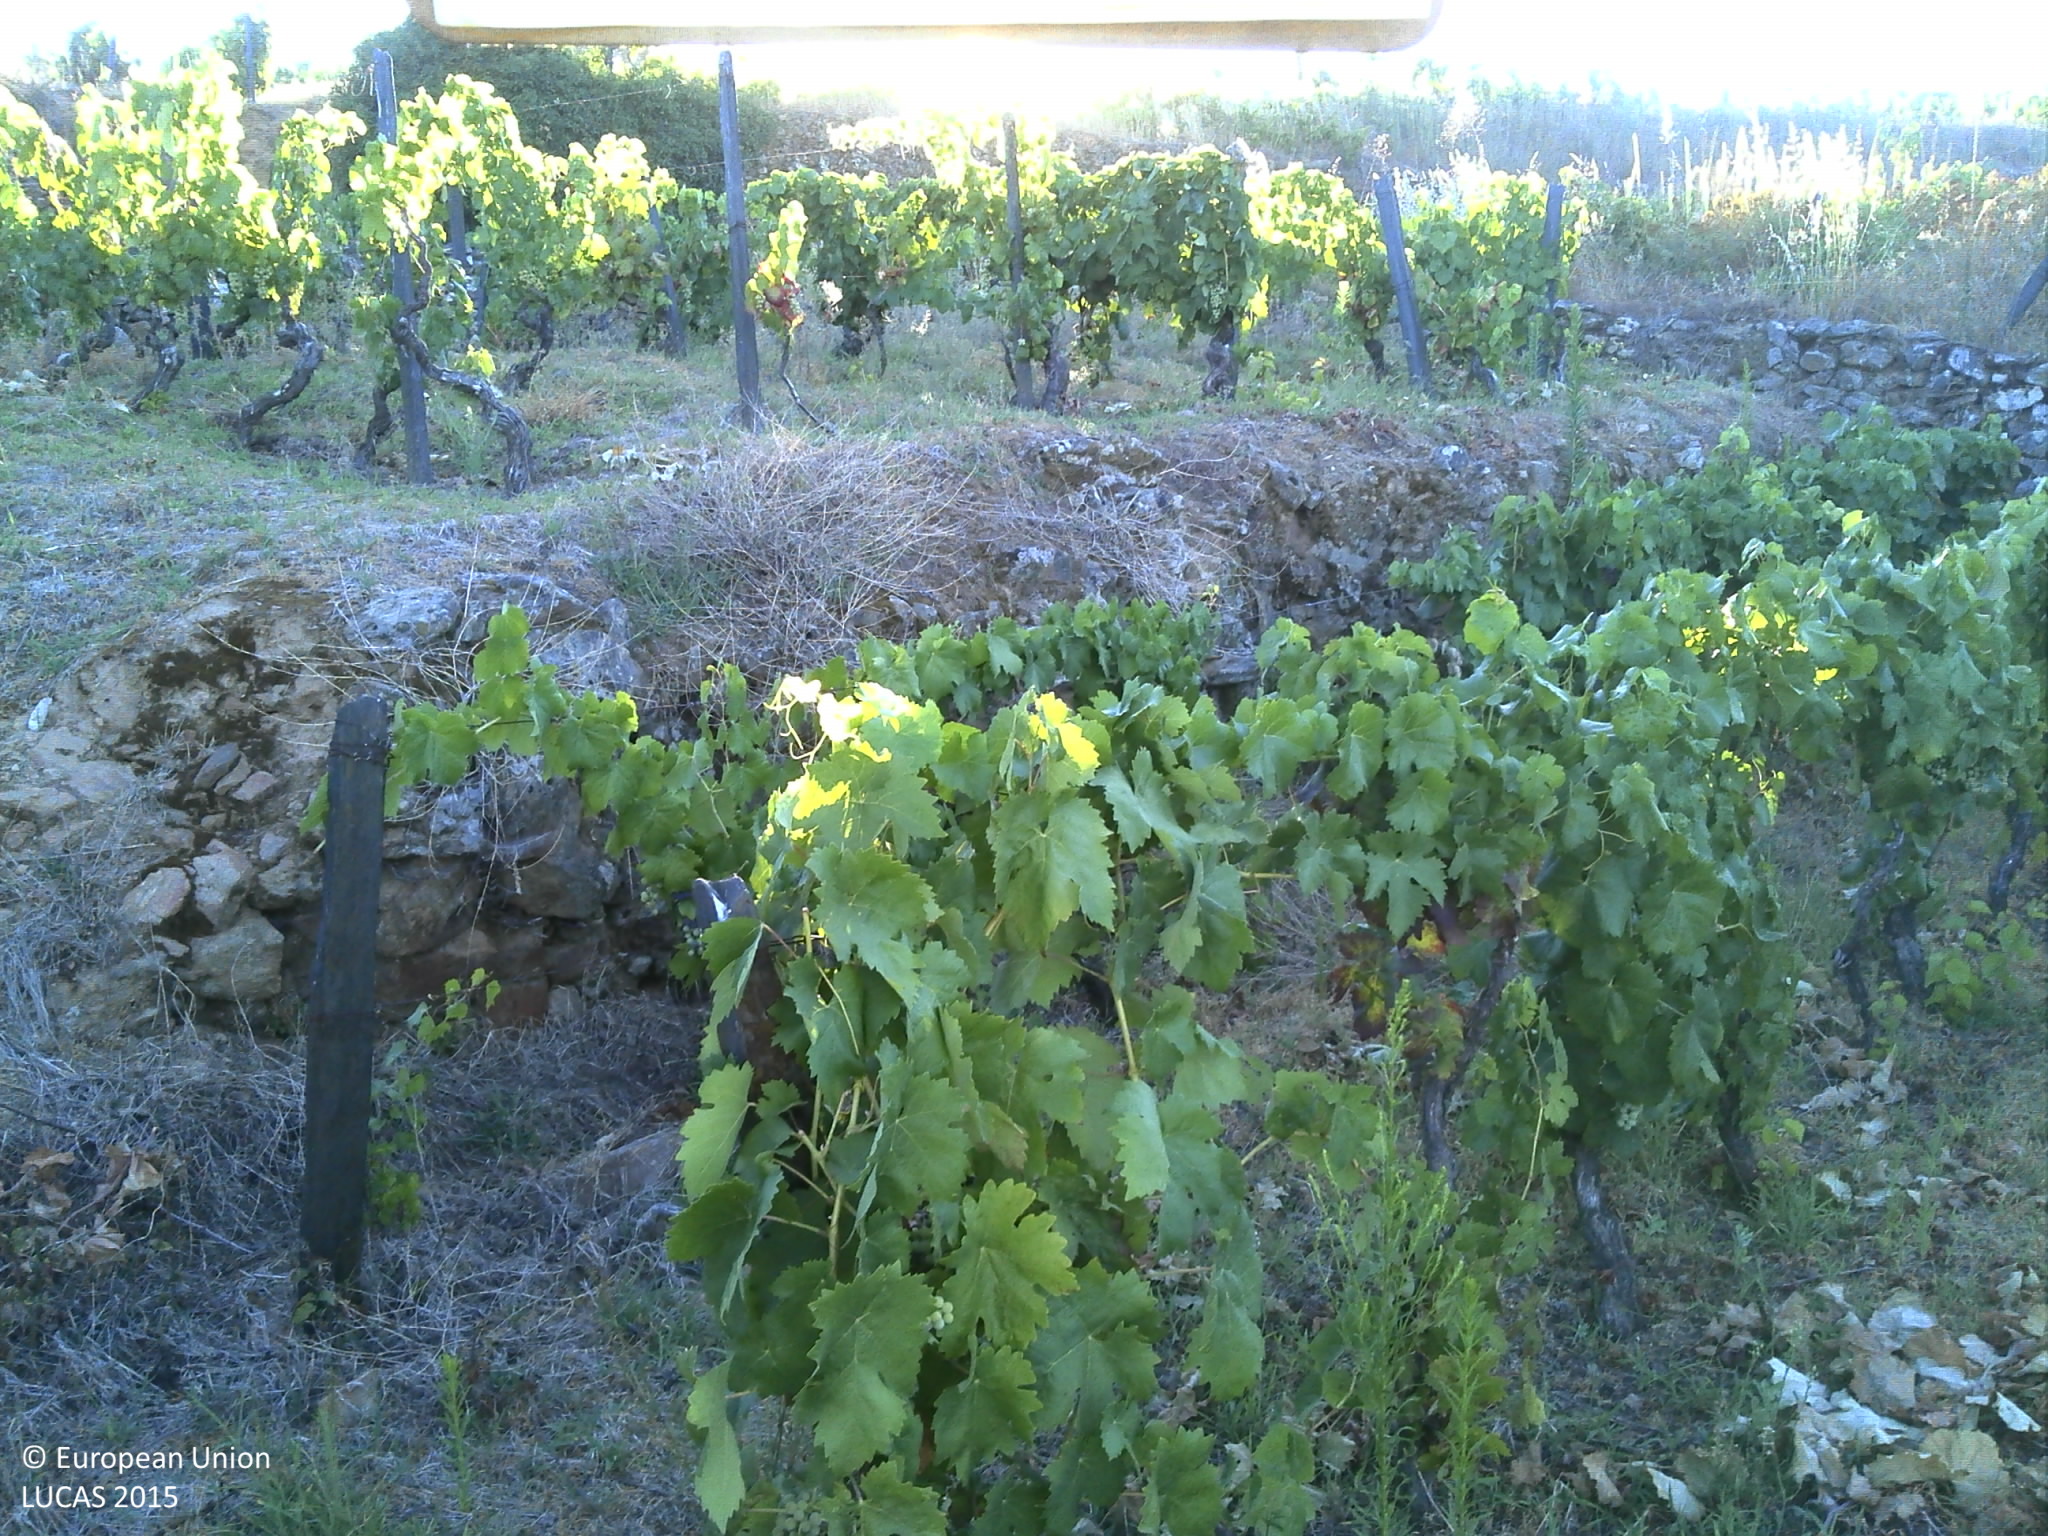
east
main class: Shrubland
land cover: Shrubland without tree cover
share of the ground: > 75 %
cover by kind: shrubs 100 %
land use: Abandoned areas
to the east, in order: Shrubland without tree cover; Vineyards; Dry stone walls; Vineyards; Dry stone walls; Tracks; Dry stone walls; Vineyards; Grass margins; Vineyards; Grass margins; Vineyards; Artificial constructions; Tracks; Dry stone walls; Vineyards; Dry stone walls; Tracks; Dry stone walls; Vineyards; Electric lines; Vineyards; Potatoes; Vineyards; Fences; Dry stone walls; Grassland with sparse tree/shrub cover
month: July
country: PT
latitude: 41.2965
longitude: -7.5244
